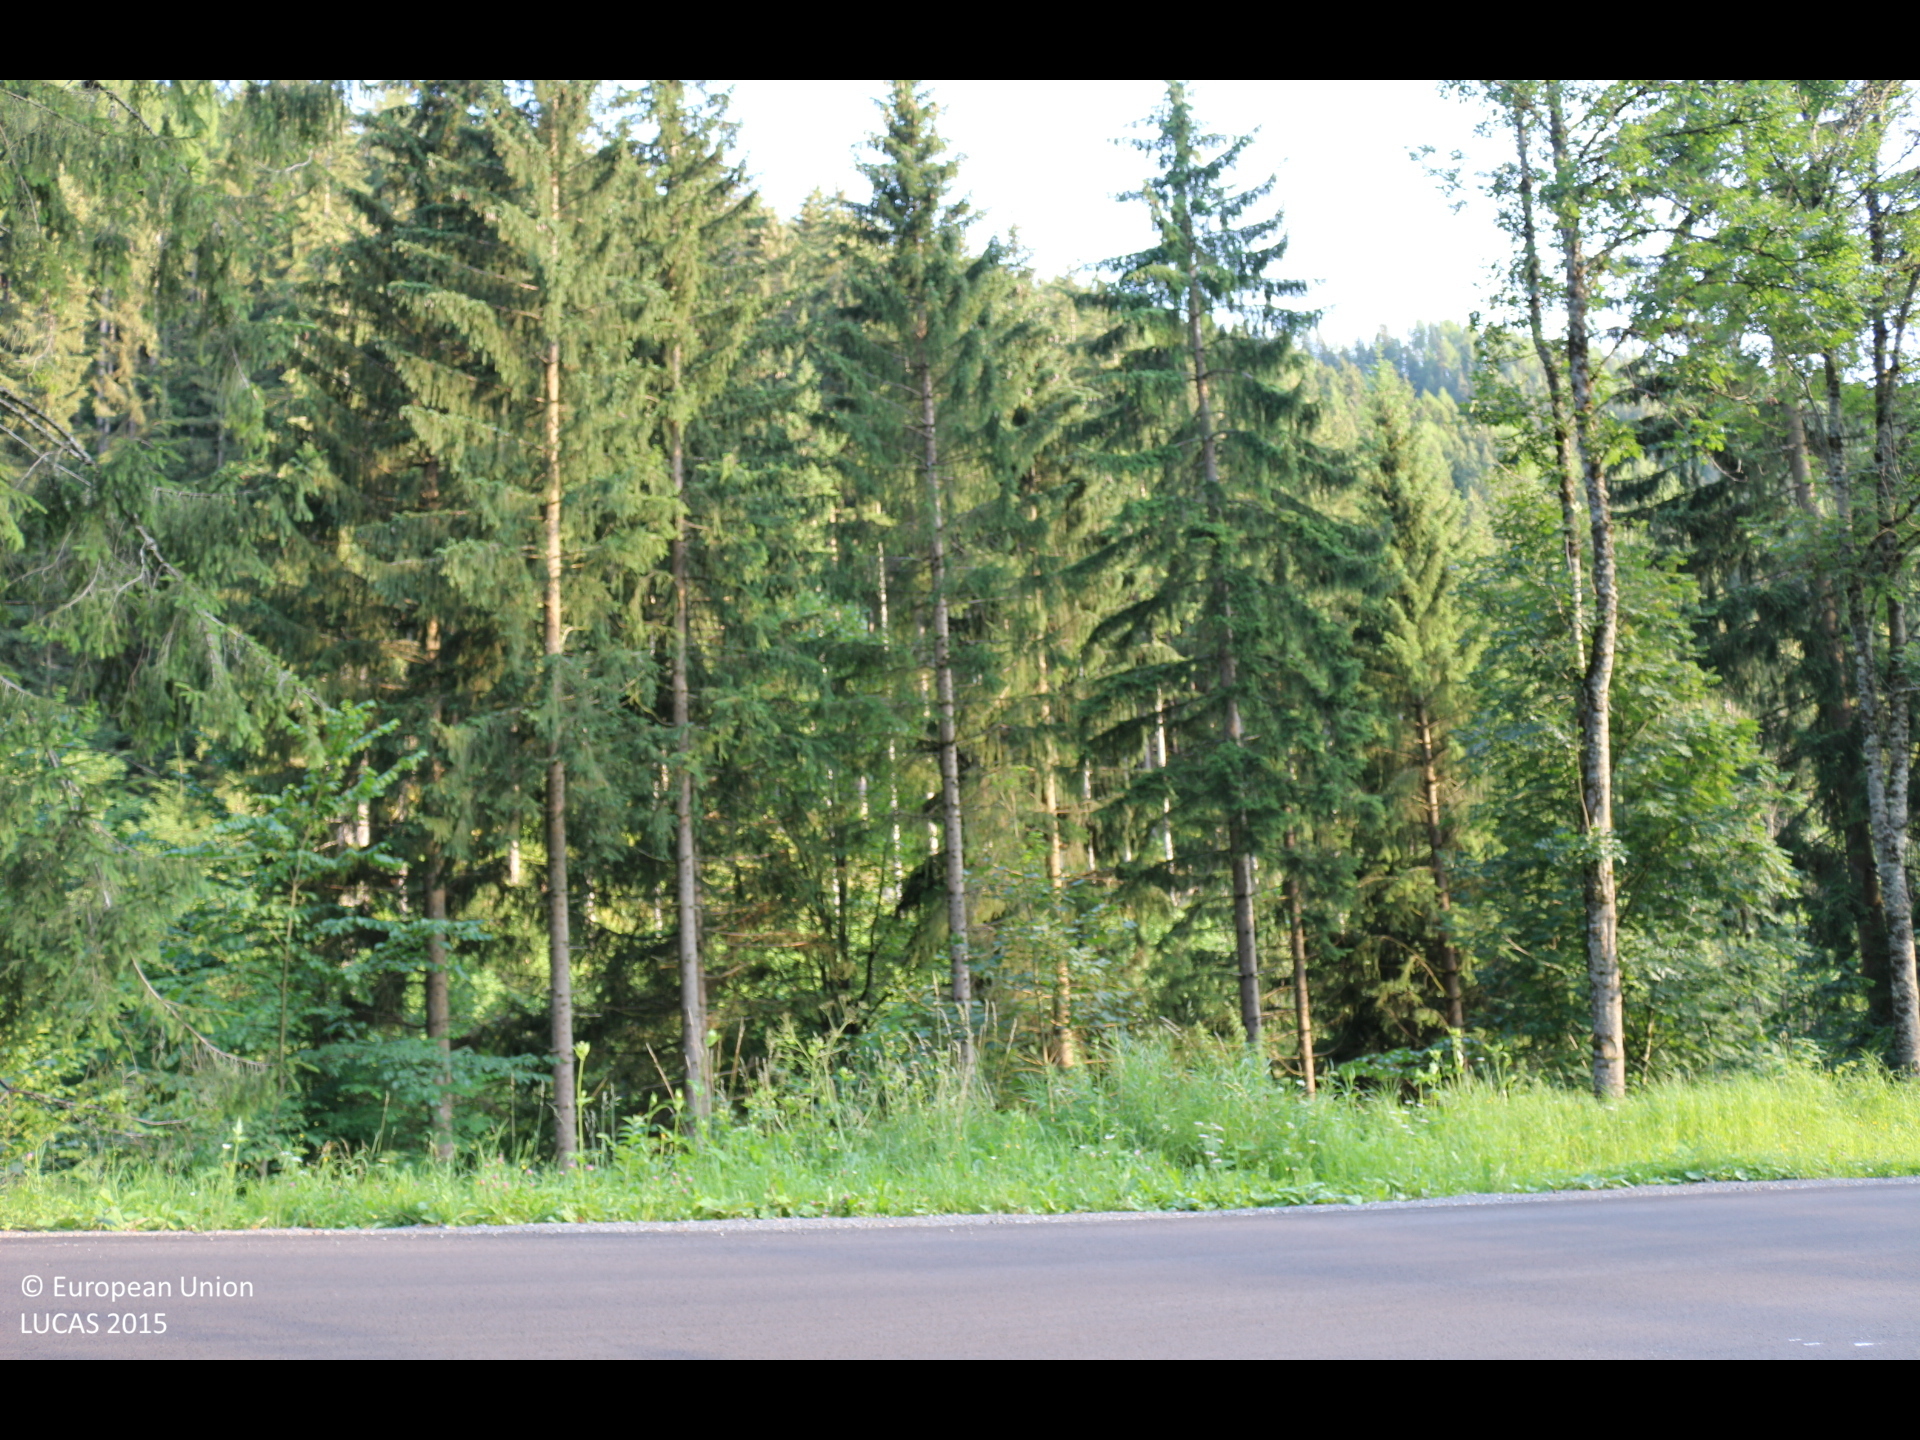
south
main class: Grassland
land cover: Grassland without tree/shrub cover
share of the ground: > 75 %
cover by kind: herbaceous plants 95 %, shrubs 5 %
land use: Road transport
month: July
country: AT
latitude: 46.9193
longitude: 14.6074
